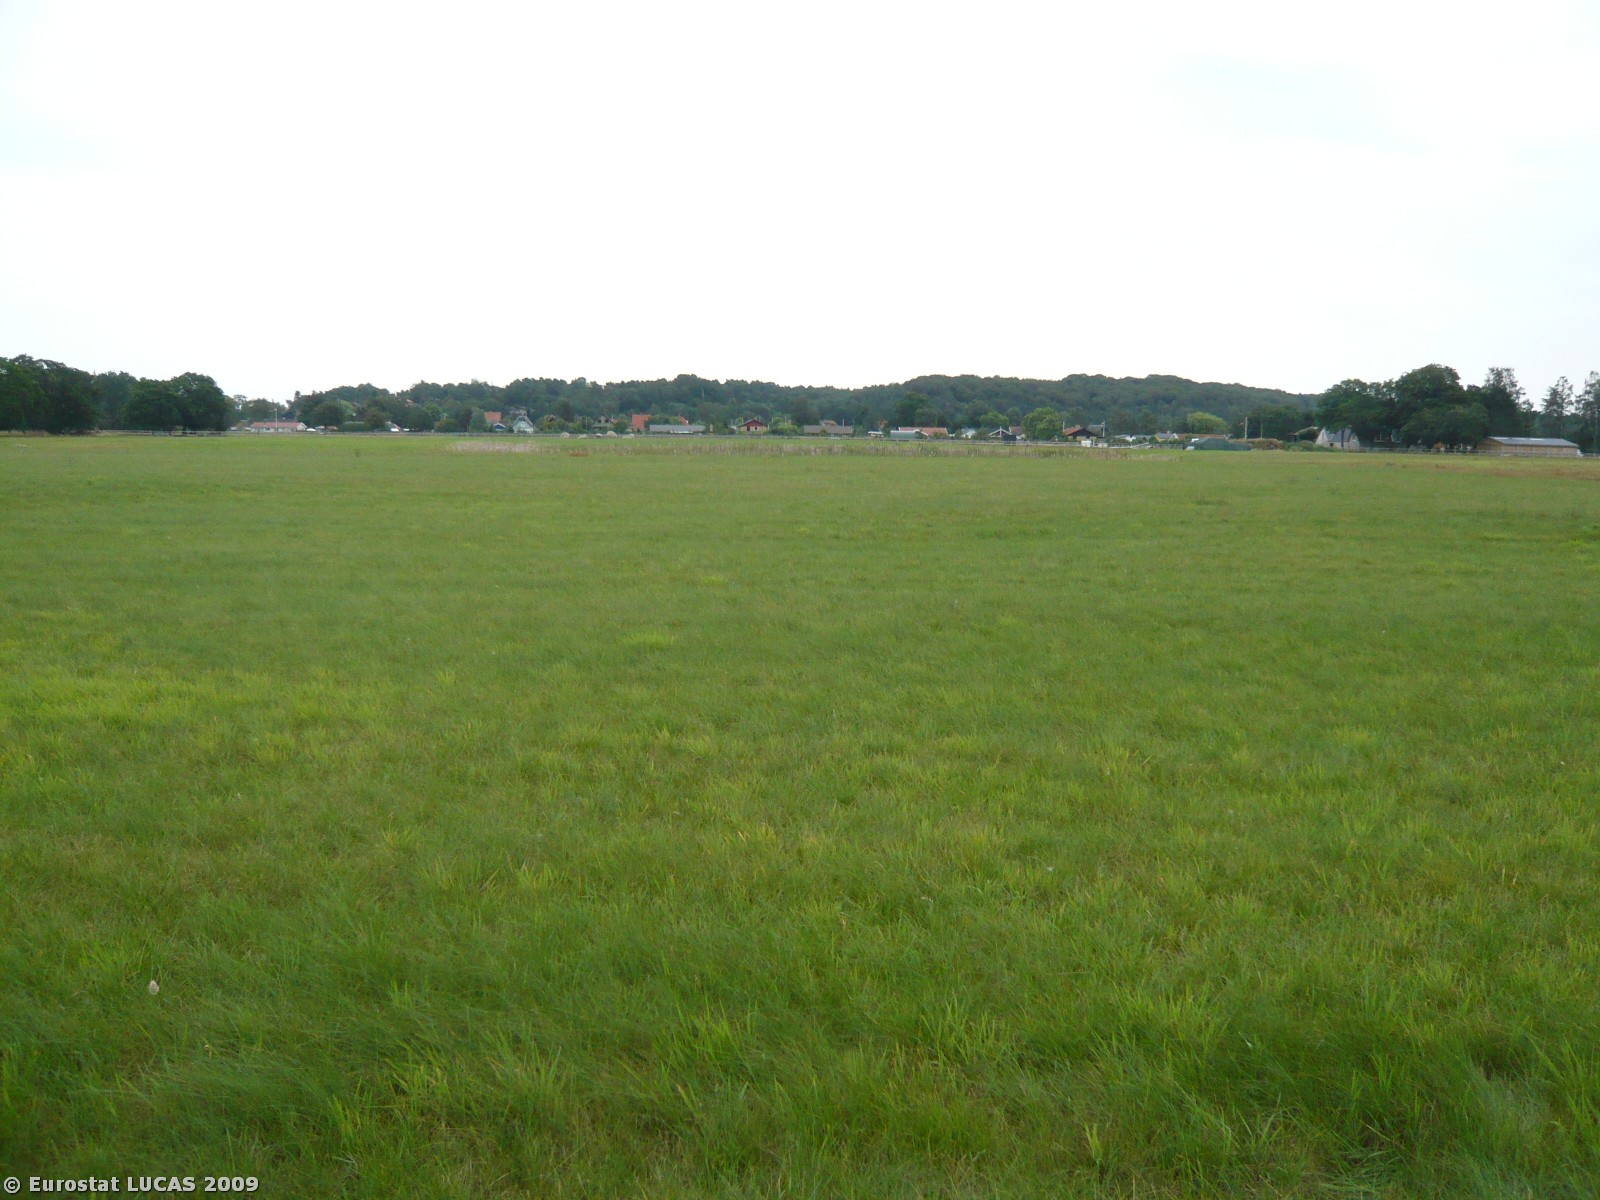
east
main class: Grassland
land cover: Grassland without tree/shrub cover
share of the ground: > 75 %
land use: Agriculture (excluding fallow land and kitchen gardens)
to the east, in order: Grassland without tree/shrub cover; Inland marshes; Inland water bodies; Inland marshes; Grassland without tree/shrub cover
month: August
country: DK
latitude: 55.9923
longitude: 12.0020
